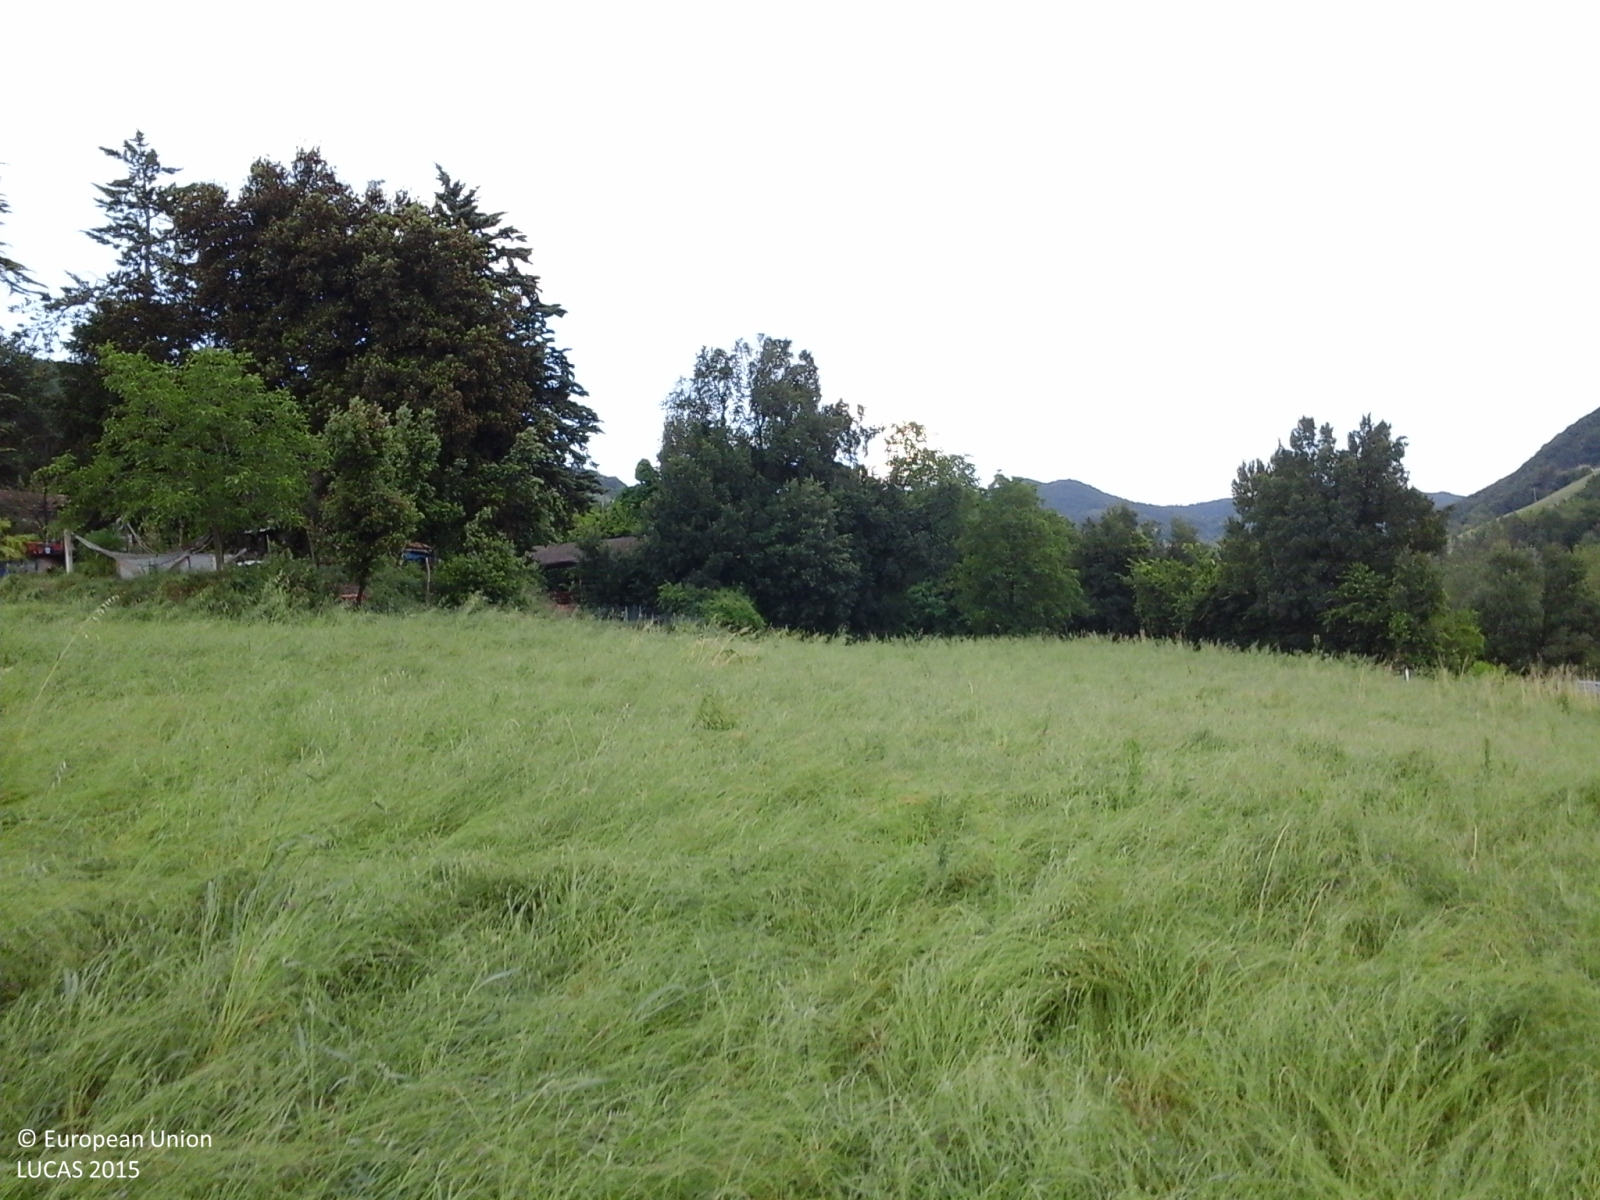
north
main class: Cropland
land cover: Other leguminous and mixtures for fodder
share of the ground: > 75 %
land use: Agriculture (excluding fallow land and kitchen gardens)
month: May
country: IT
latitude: 44.0444
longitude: 11.9049
